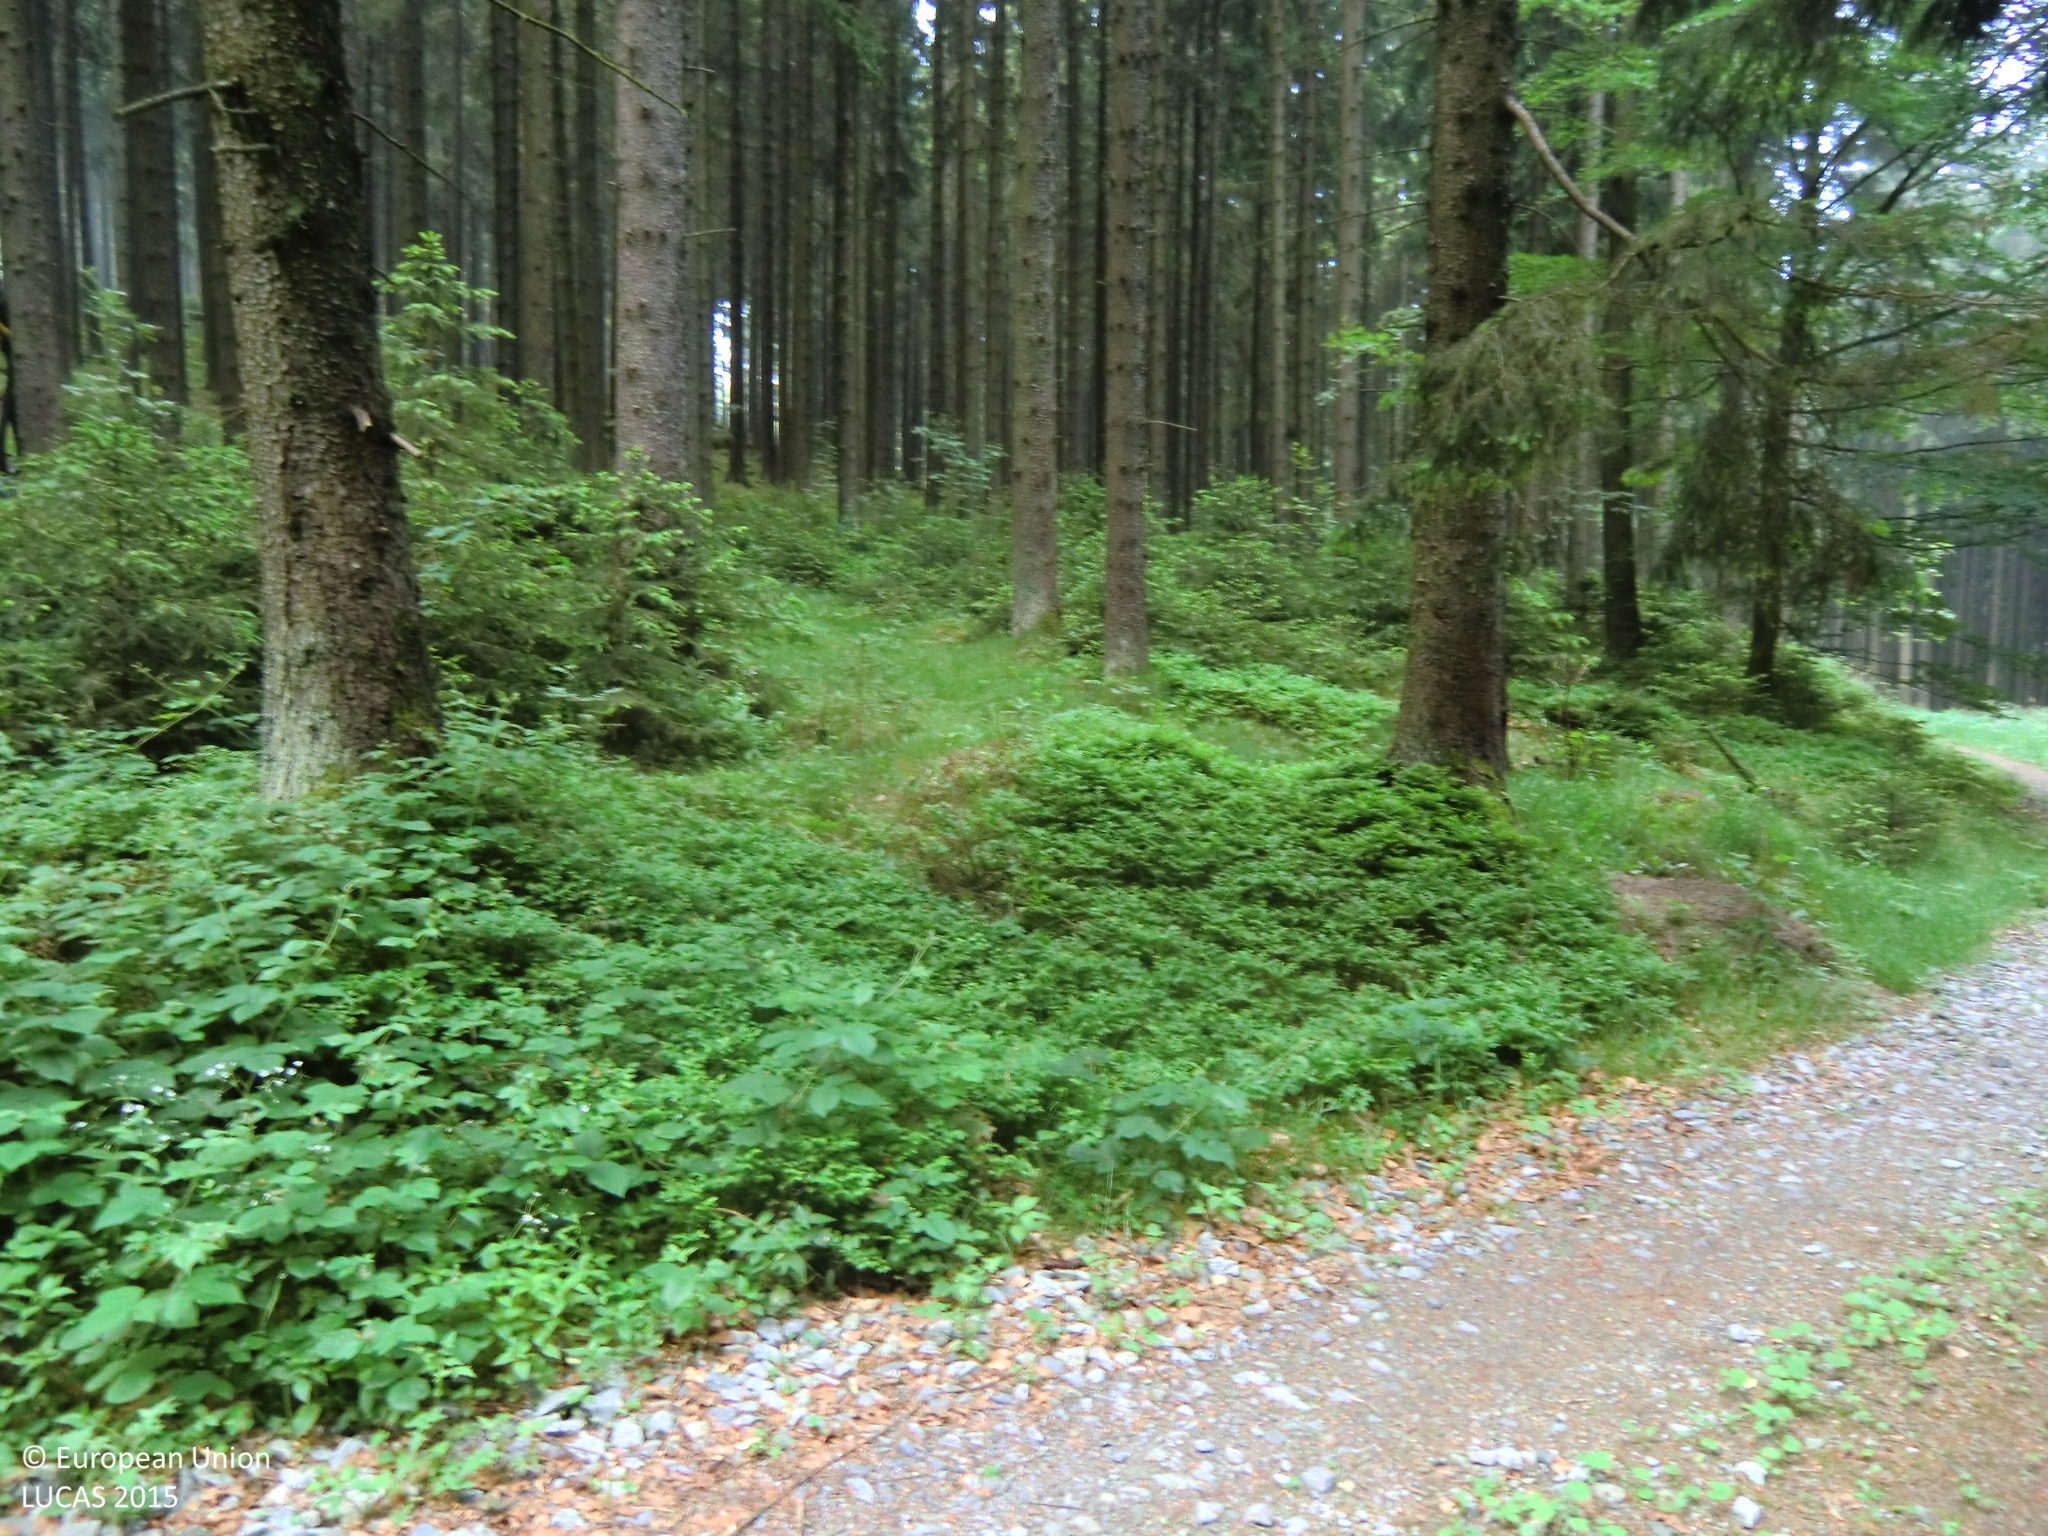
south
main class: Woodland
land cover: Spruce dominated mixed woodland
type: hemiboreal forest and nemoral coniferous forest and mixed broadleaved-coniferous forest
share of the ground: 50 - 75 %
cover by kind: herbaceous plants 40 %, coniferous forest trees 30 %, broadleaved forest trees 30 %
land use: Forestry
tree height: > 5 m
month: June
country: AT
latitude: 48.5344
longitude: 14.7818
